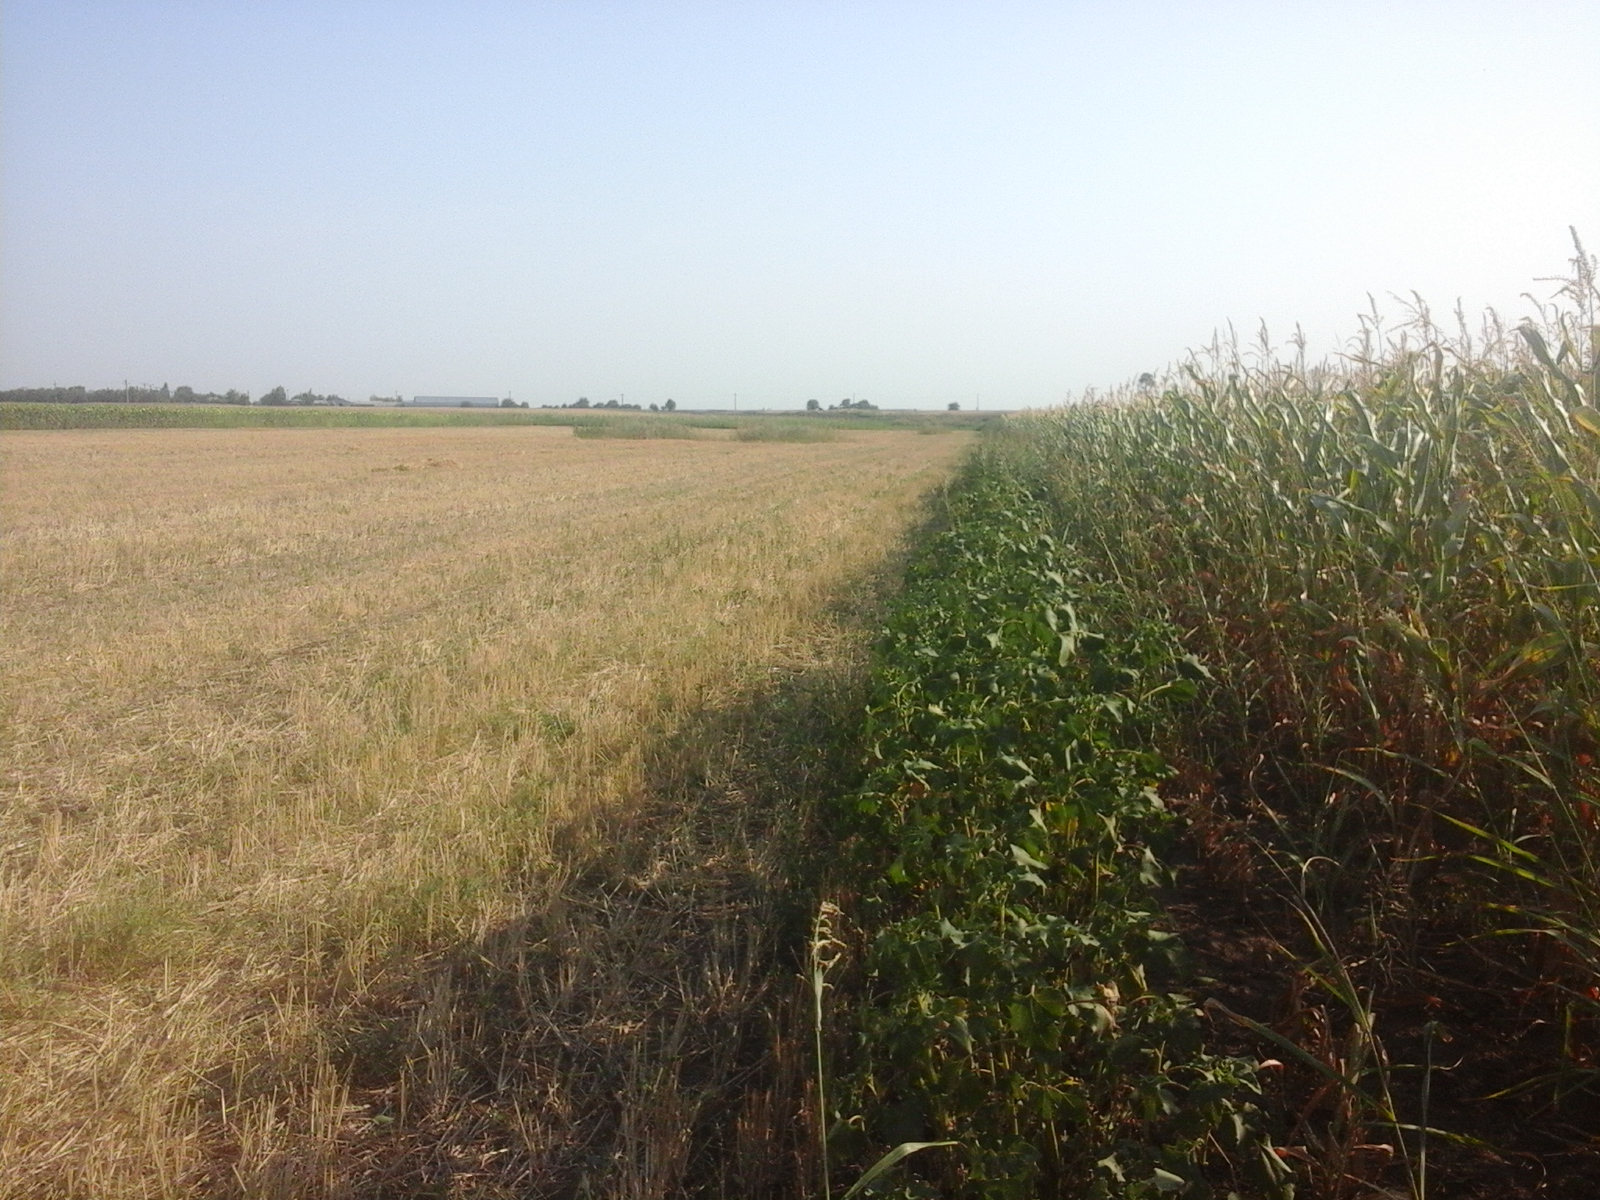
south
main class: Cropland
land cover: Common wheat
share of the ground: > 75 %
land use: Agriculture (excluding fallow land and kitchen gardens)
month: August
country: RO
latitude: 45.0149
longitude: 27.5467
